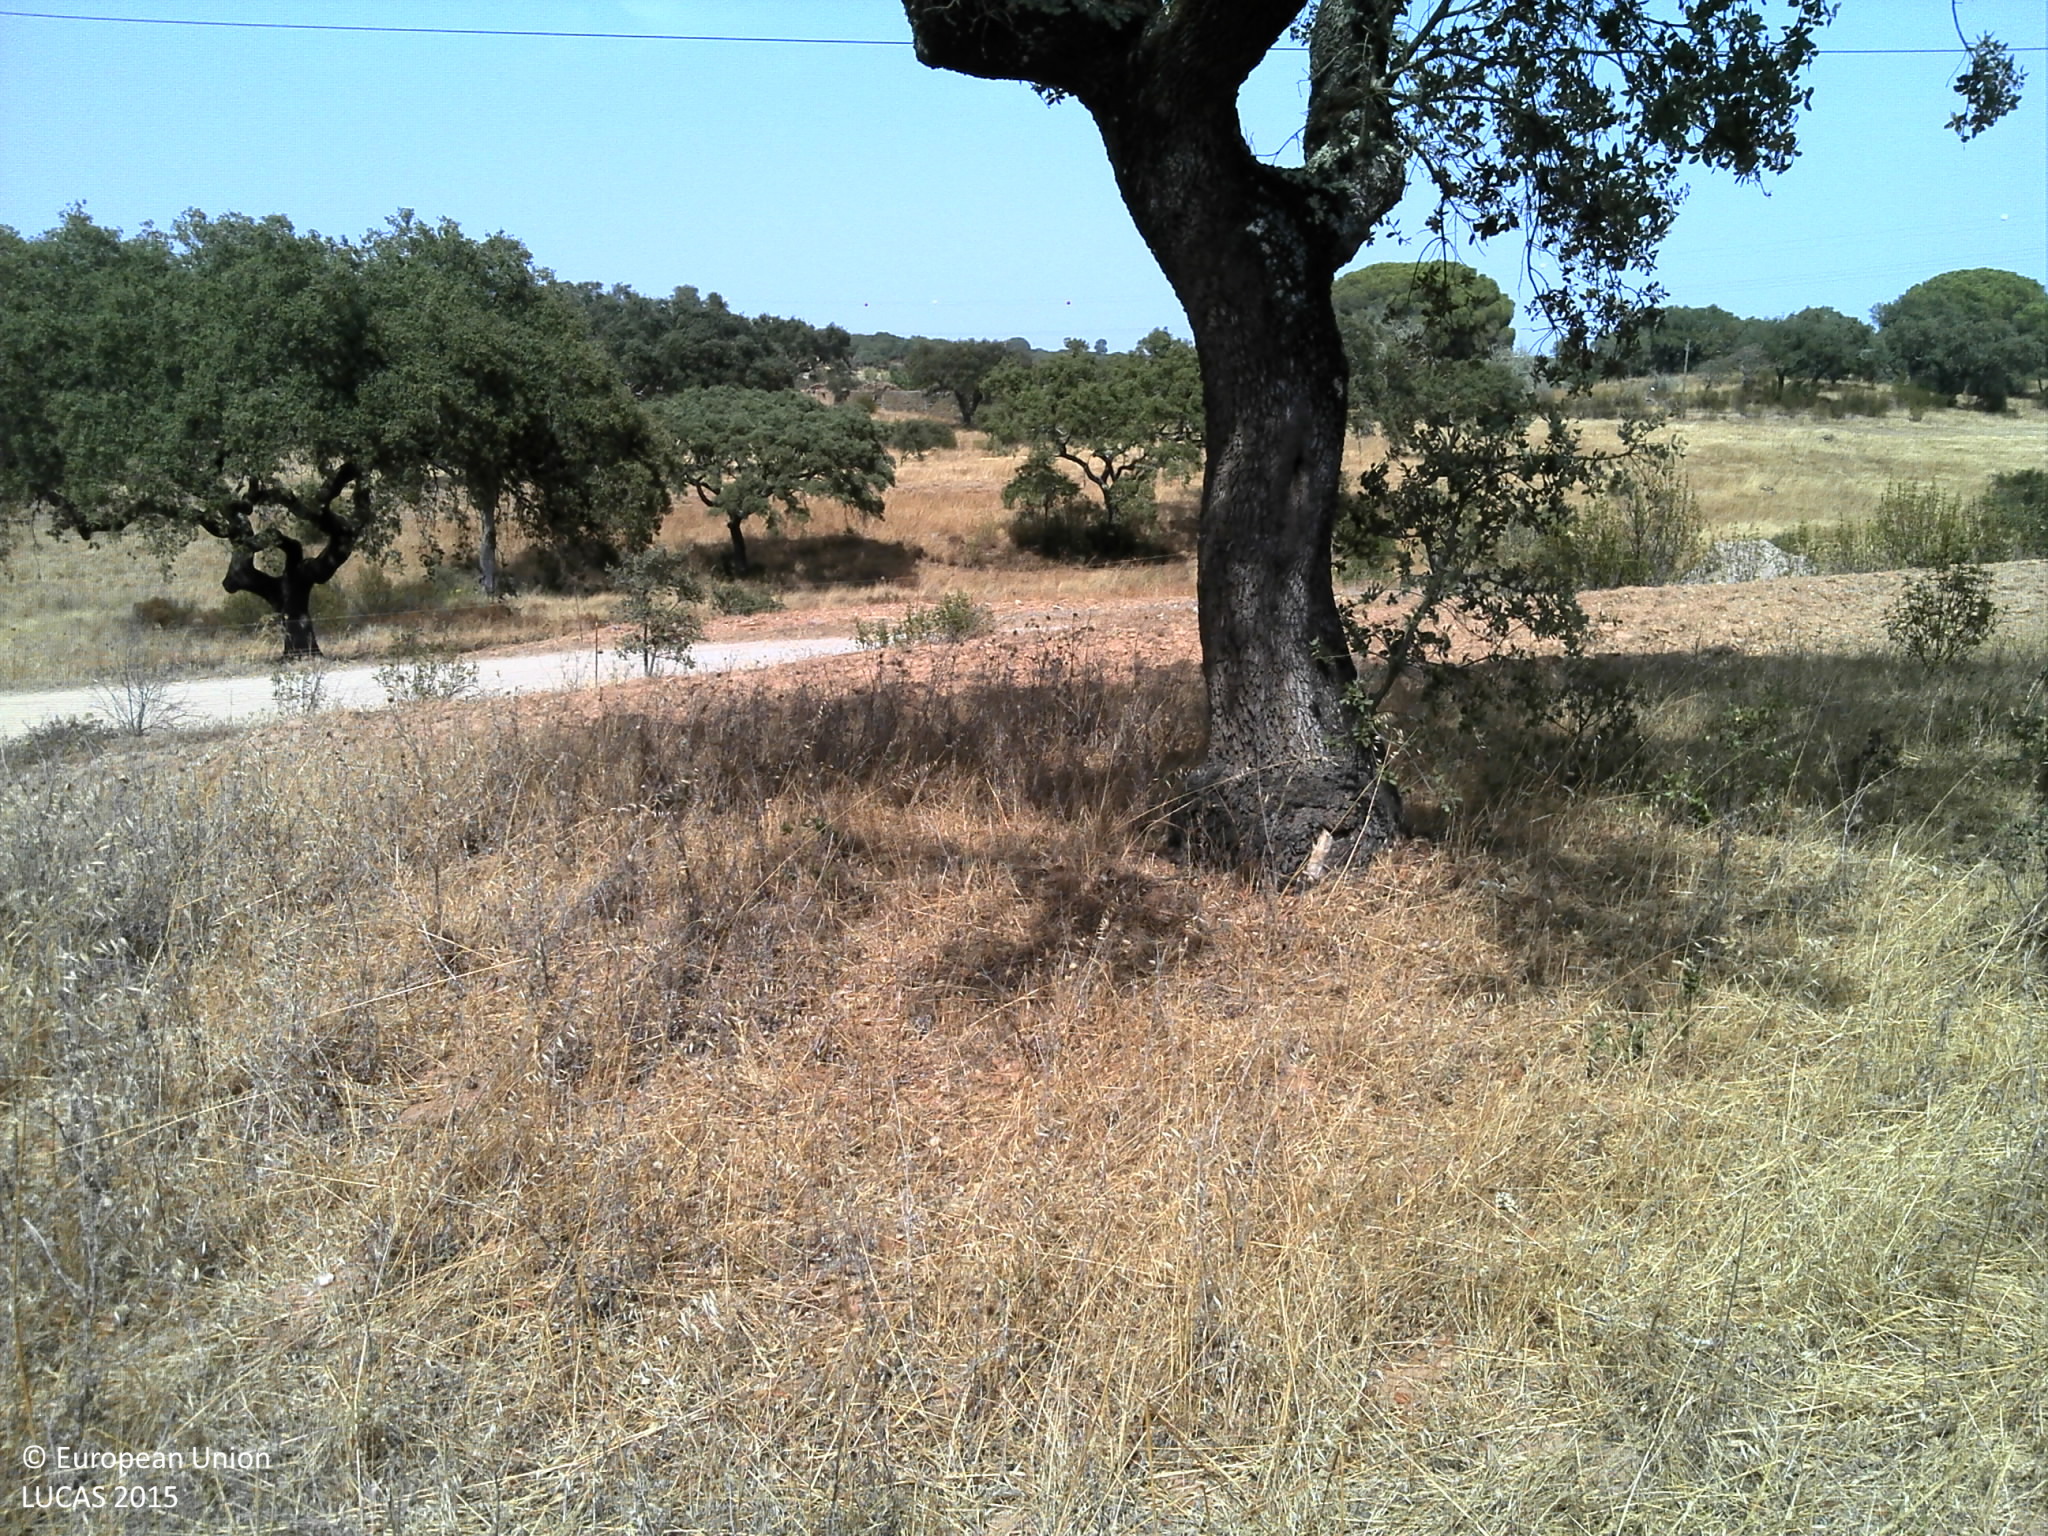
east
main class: Woodland
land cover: Broadleaved woodland
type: broadleaved evergreen forest
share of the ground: 10 - 25 %
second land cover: Grassland without tree/shrub cover
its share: 50 - 75 %
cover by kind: herbaceous plants 50 %, consolidated bare surface 35 %, broadleaved forest trees 15 %
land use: Forestry
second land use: Agriculture (excluding fallow land and kitchen gardens)
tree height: > 5 m
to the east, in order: Broadleaved woodland; Grassland without tree/shrub cover; Other structural elements; Fences; Electric lines; Tracks; Fences; Other structural elements; Grassland without tree/shrub cover; Broadleaved woodland; Rivers and streams; Grassland without tree/shrub cover; Other structural elements; Electric lines; Tracks; Broadleaved woodland
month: July
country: PT
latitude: 37.6387
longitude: -8.2172
